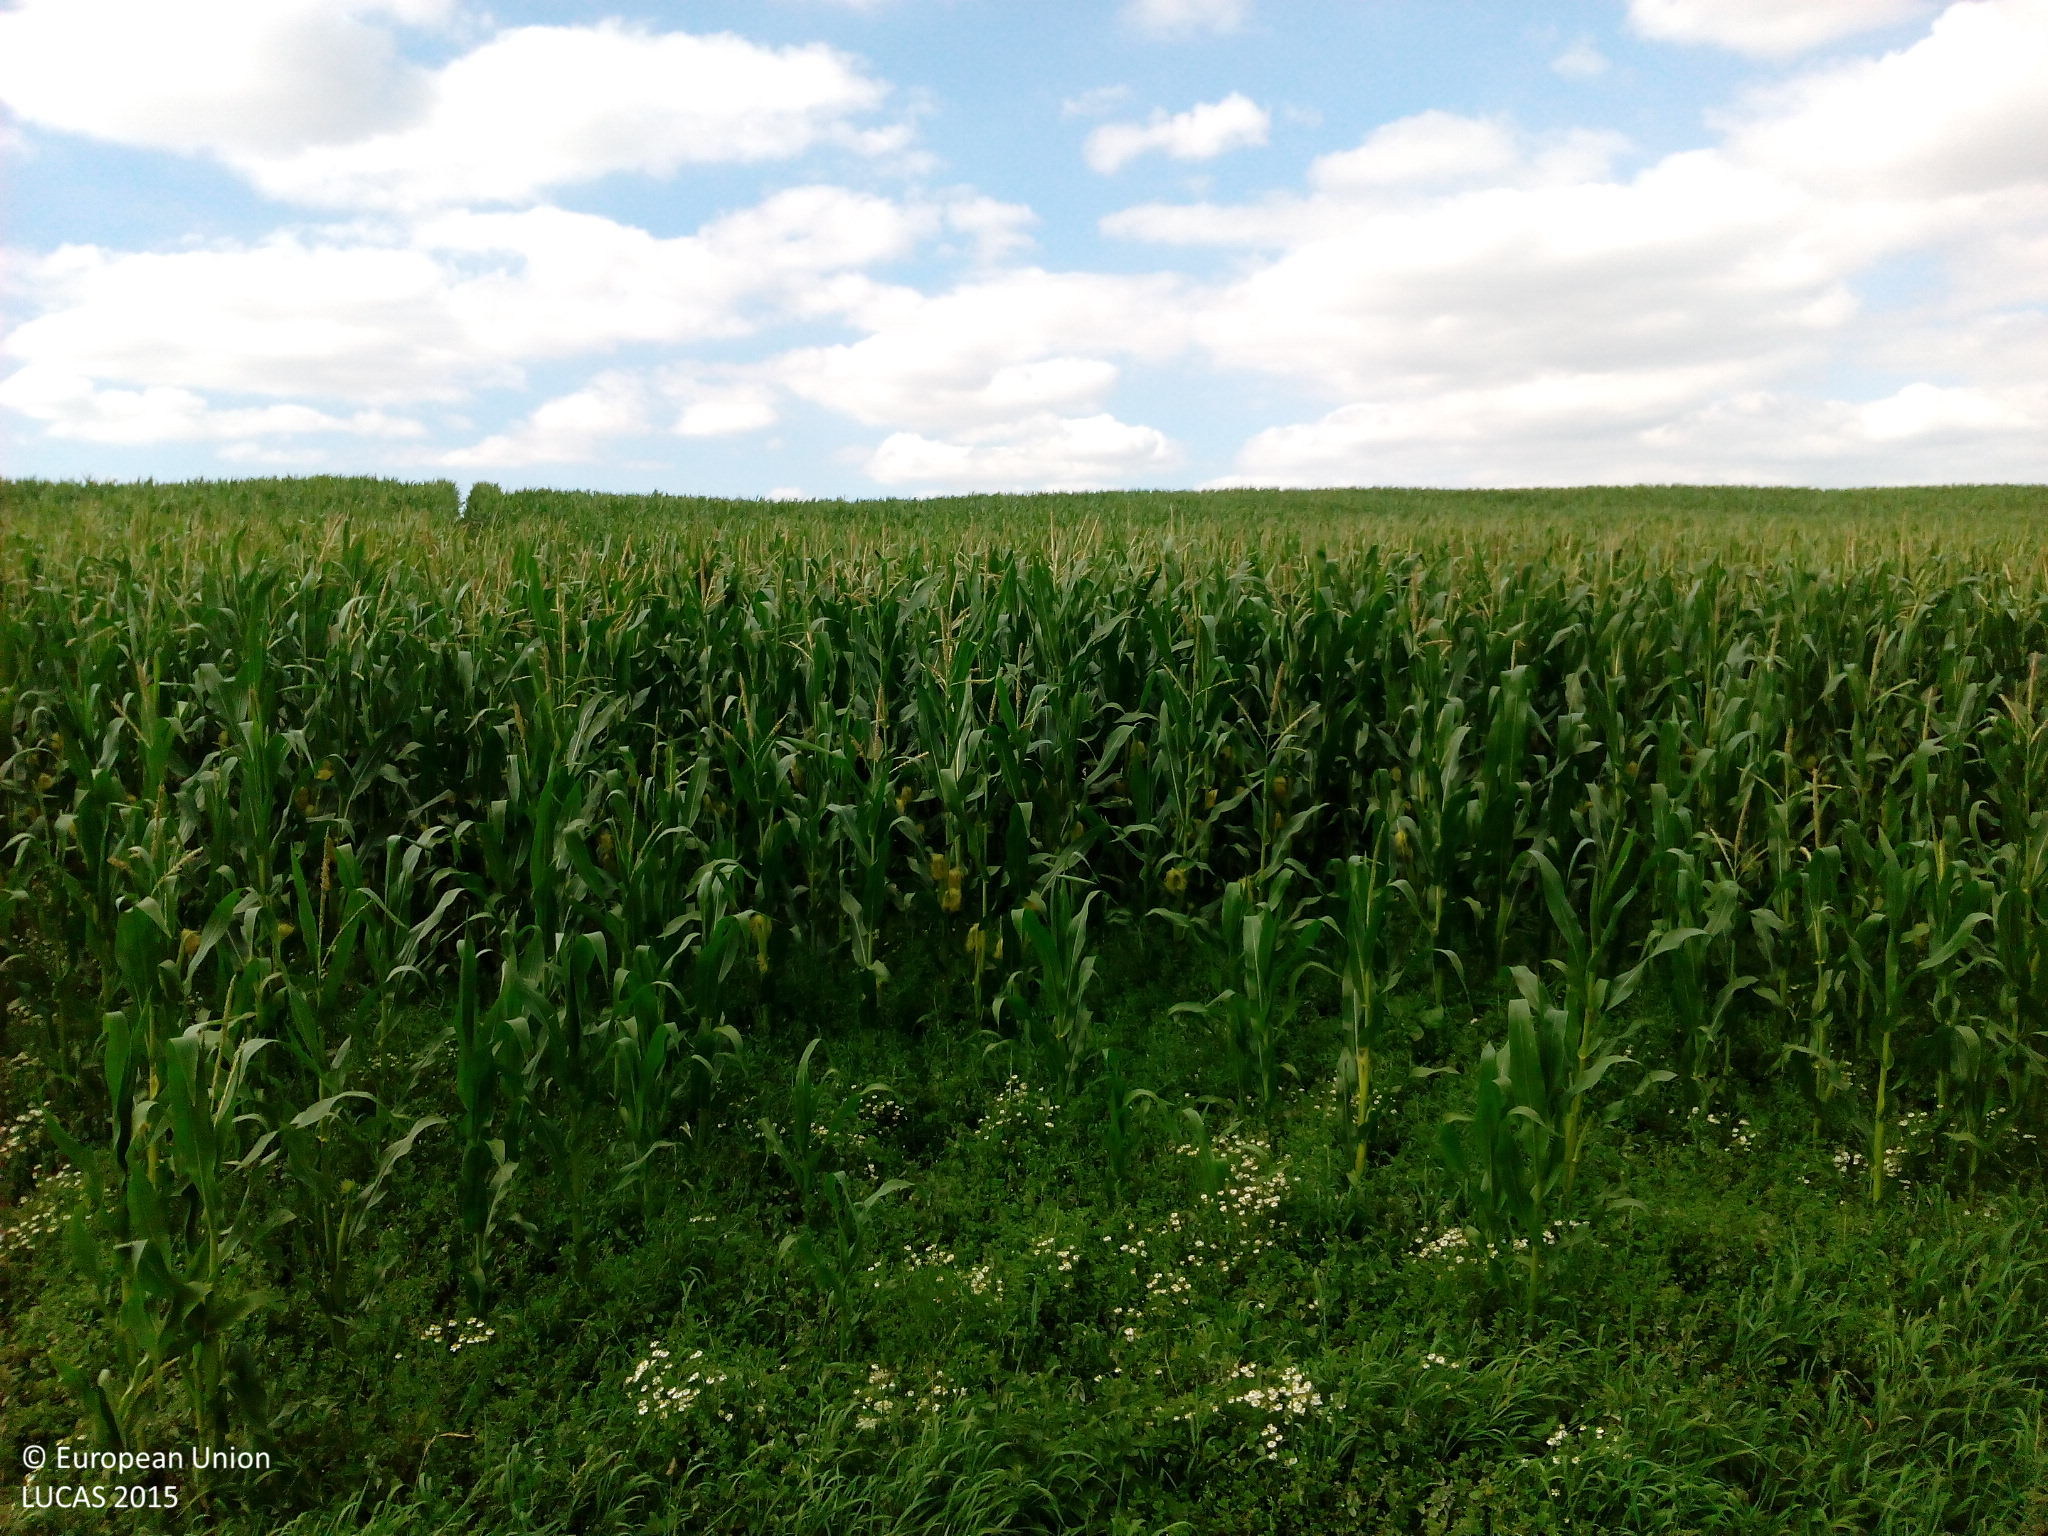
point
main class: Cropland
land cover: Maize
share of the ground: > 75 %
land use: Agriculture (excluding fallow land and kitchen gardens)
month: August
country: DE
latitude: 53.4726
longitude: 13.6609
